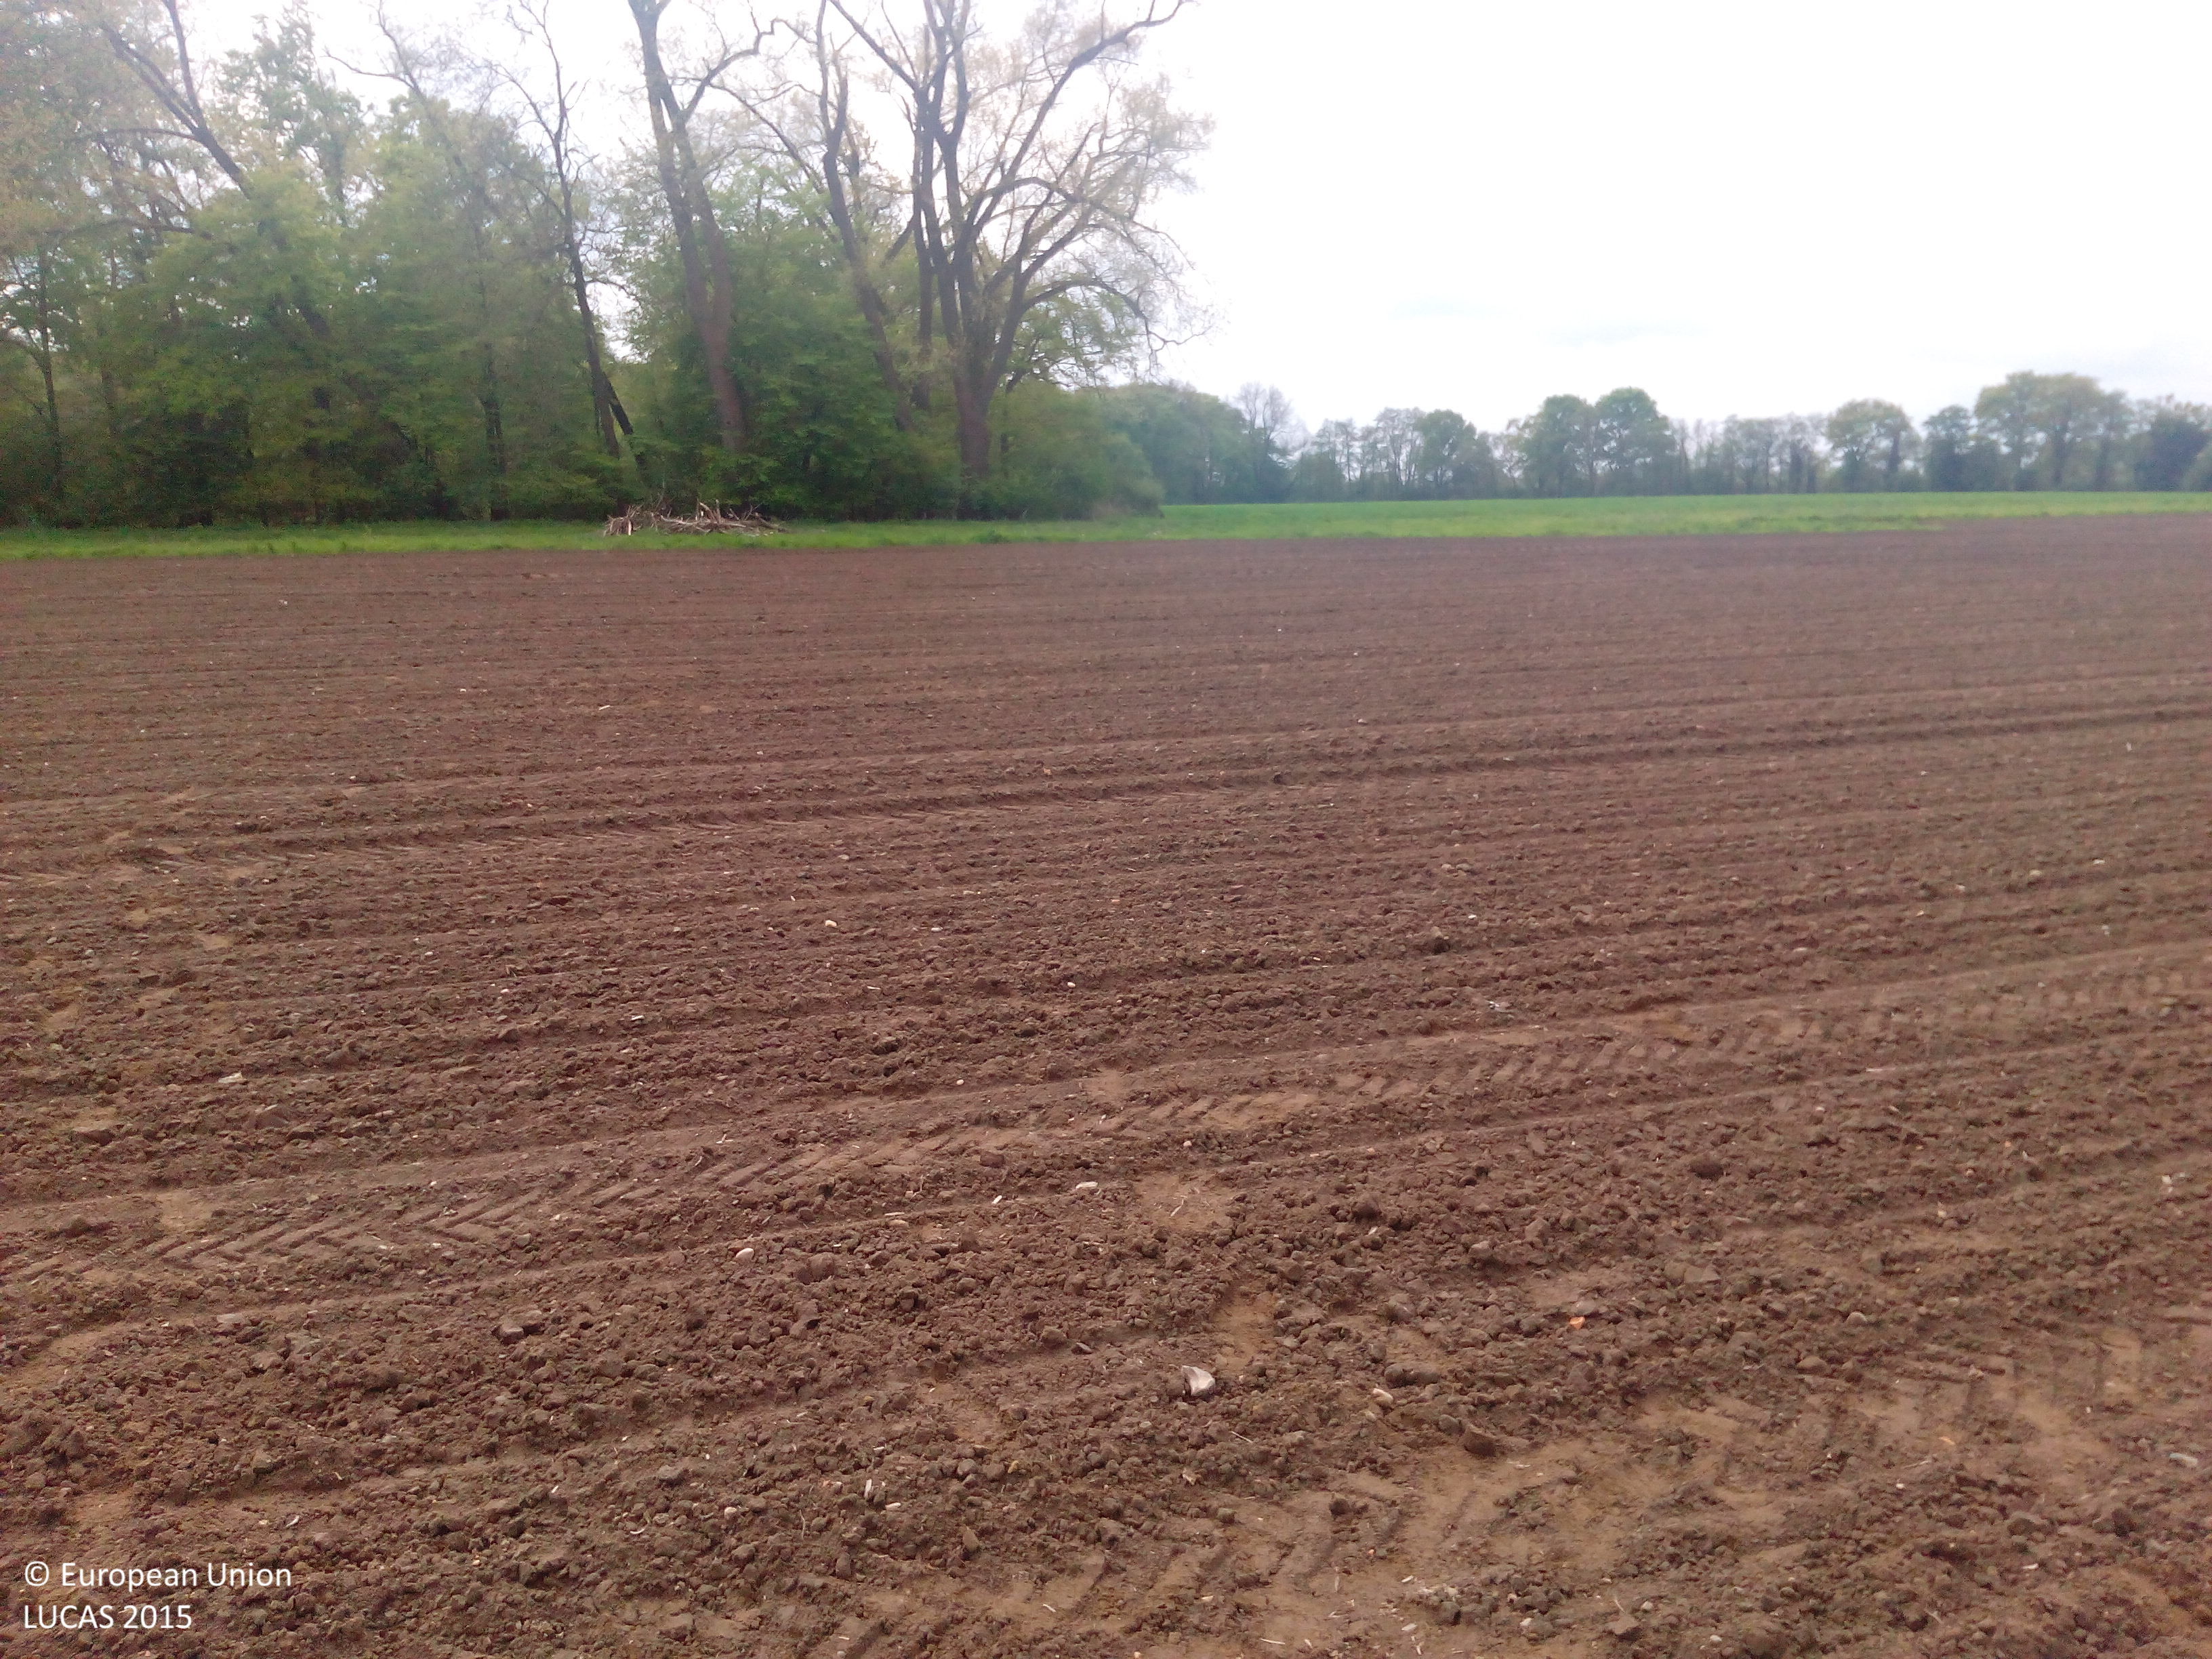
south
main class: Cropland
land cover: Maize
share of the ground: < 10 %
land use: Agriculture (excluding fallow land and kitchen gardens)
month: May
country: DE
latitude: 51.9007
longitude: 7.4569
